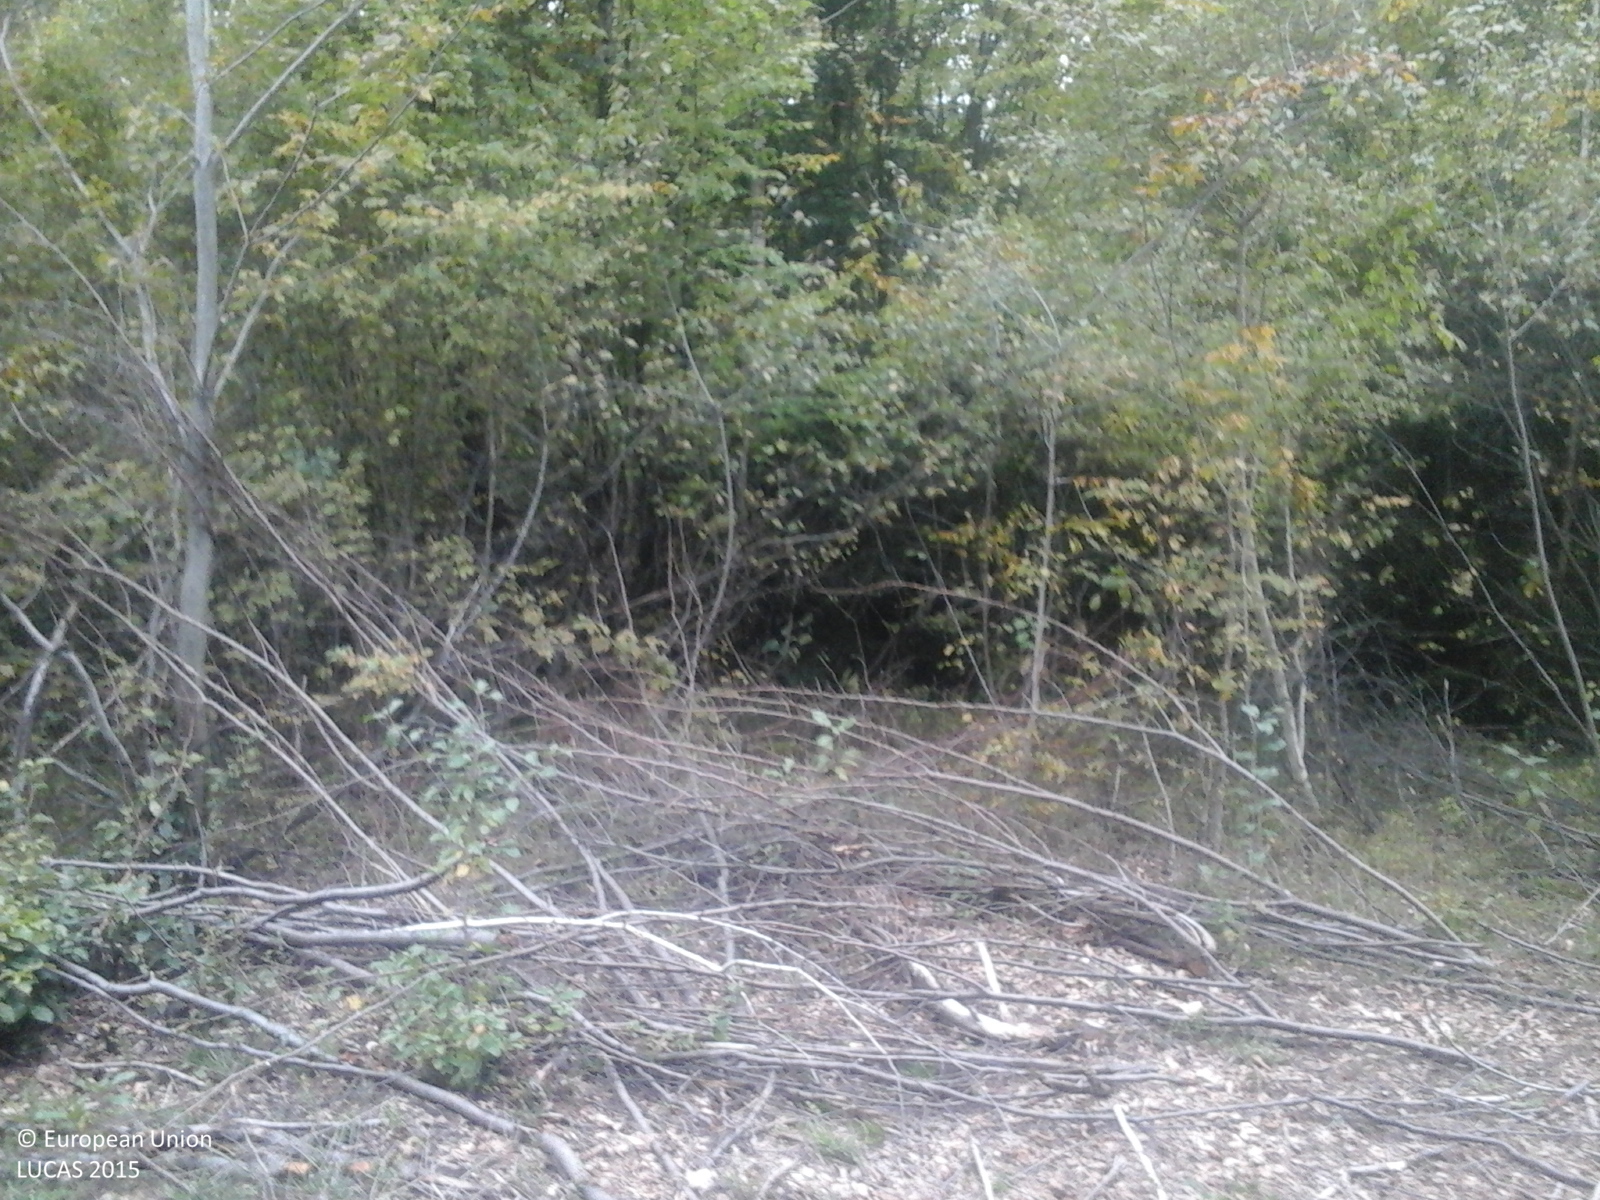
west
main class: Woodland
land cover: Broadleaved woodland
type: beech forest
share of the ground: > 75 %
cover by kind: broadleaved forest trees 100 %
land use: Forestry
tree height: > 5 m
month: October
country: RO
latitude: 45.7035
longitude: 24.7672
